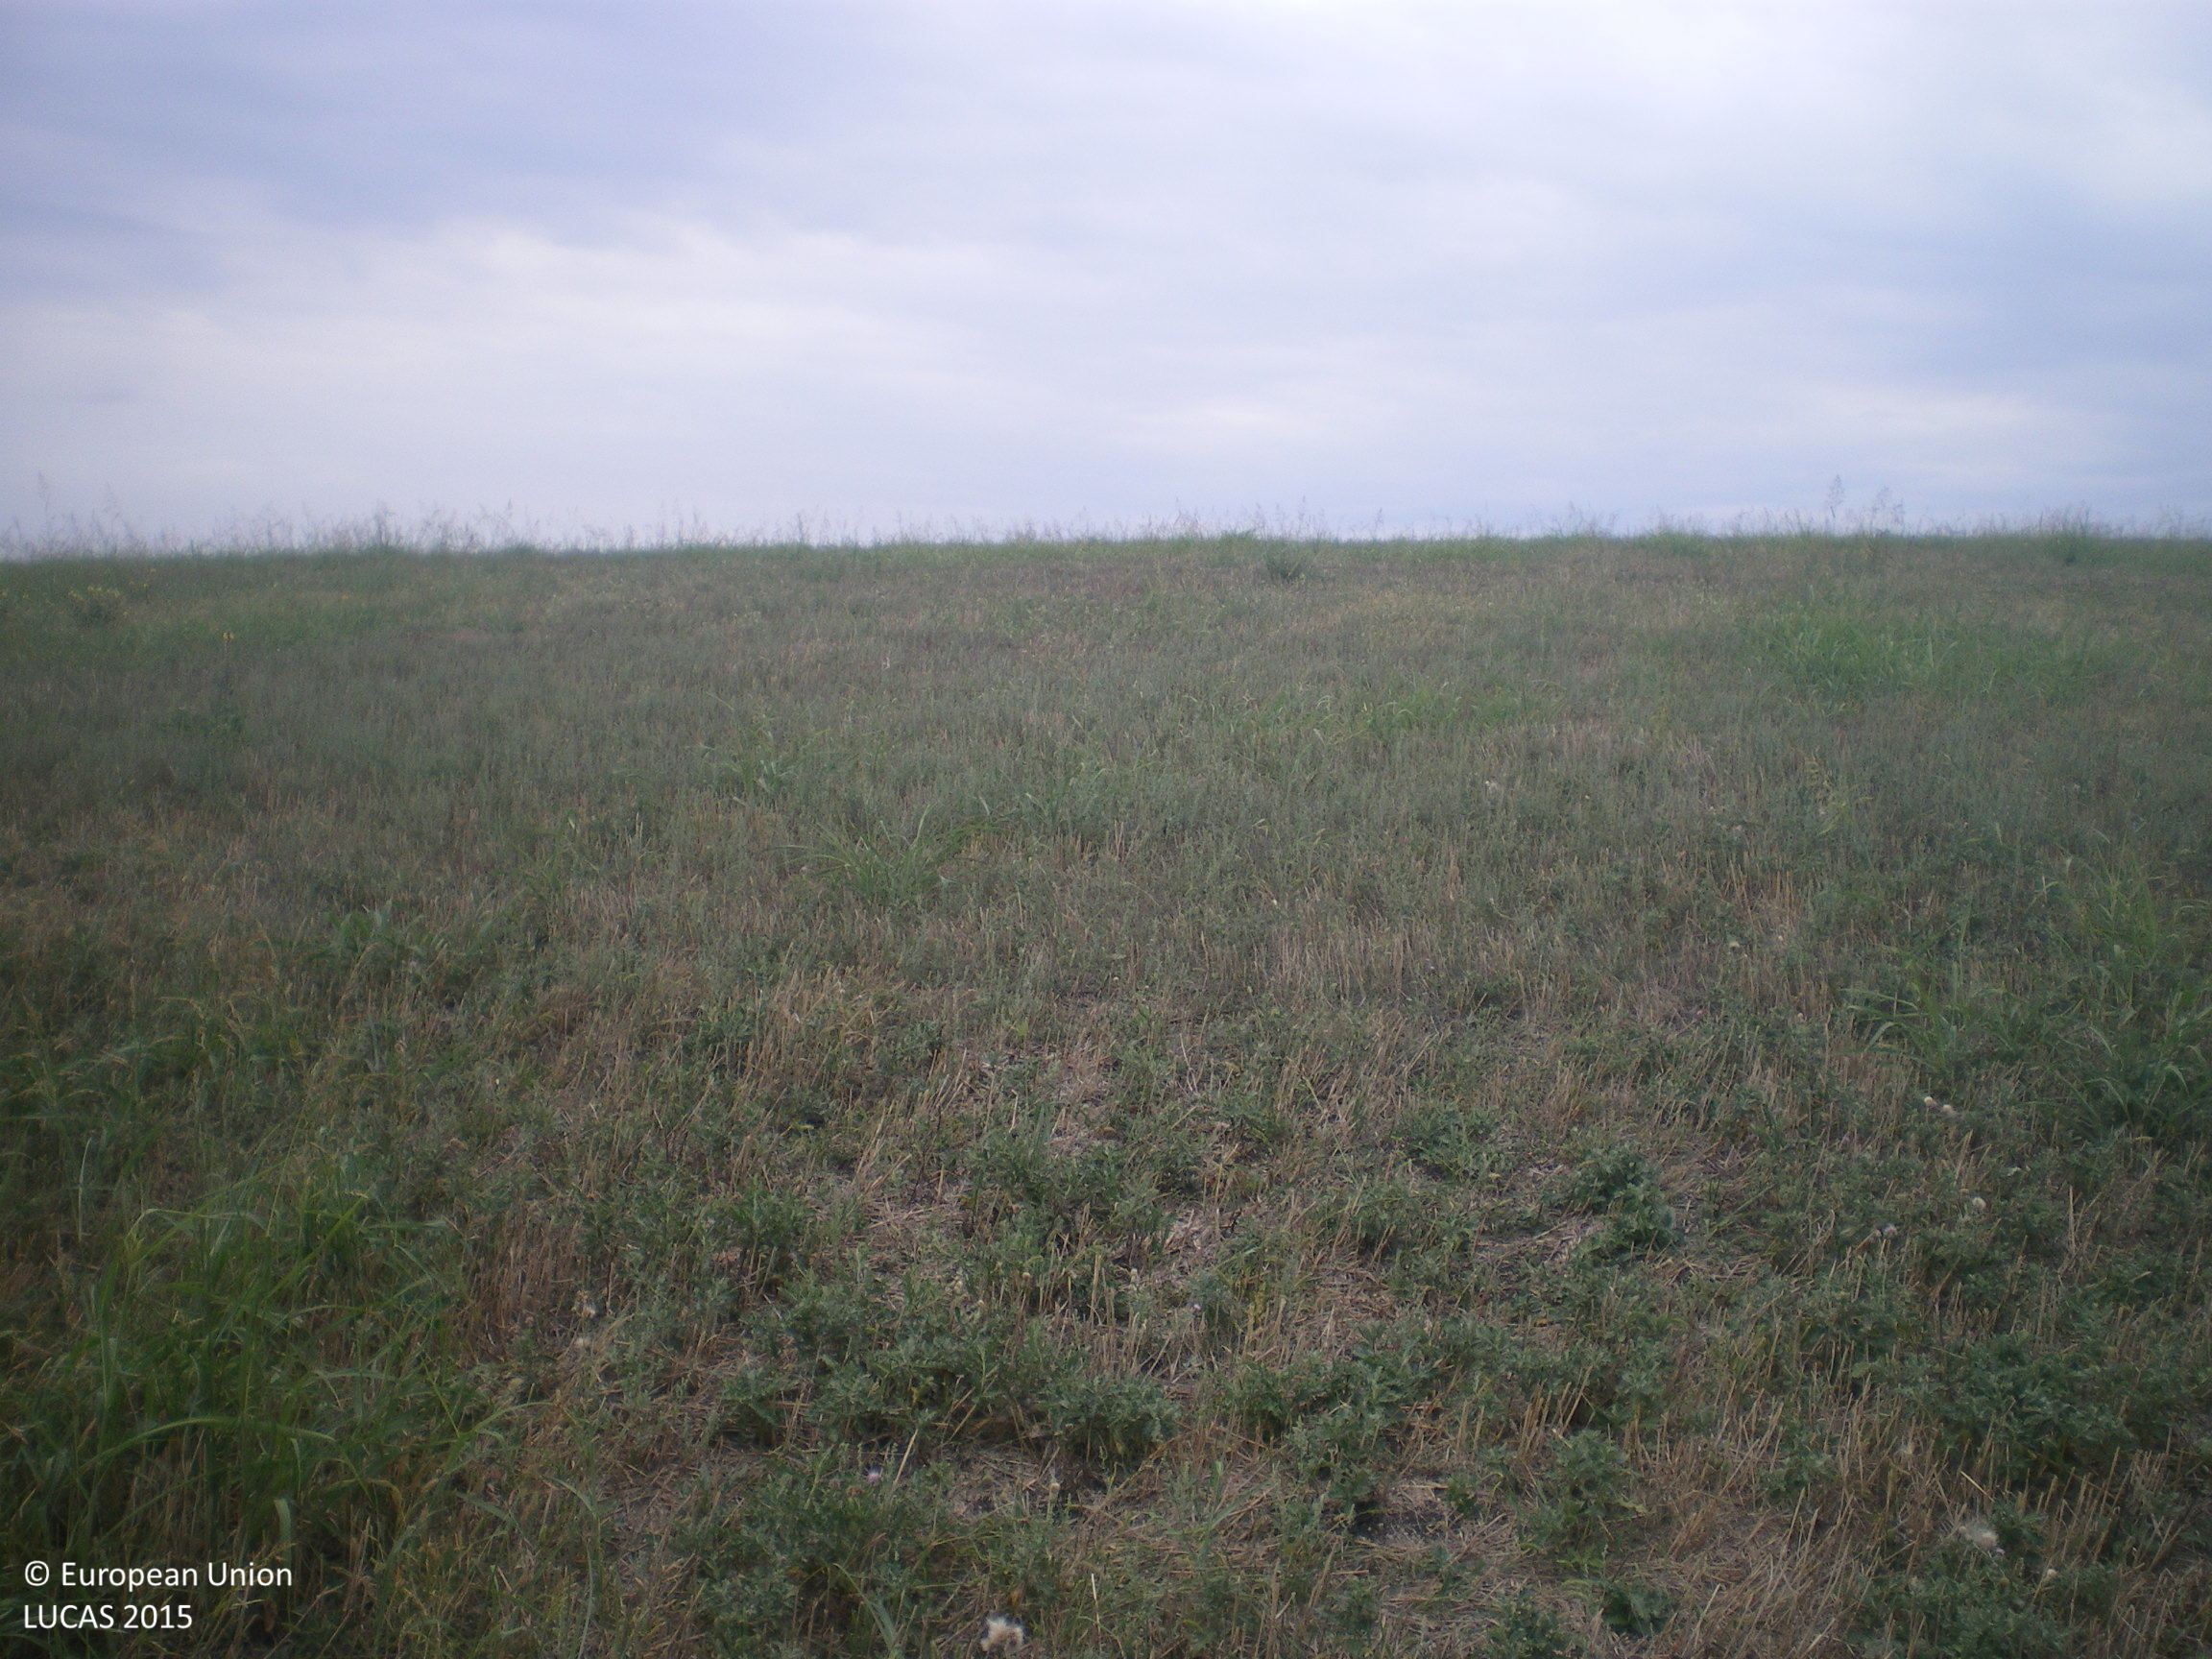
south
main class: Cropland
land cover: Rye
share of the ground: 10 - 25 %
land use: Agriculture (excluding fallow land and kitchen gardens)
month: September
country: BG
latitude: 42.2255
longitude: 25.8363
